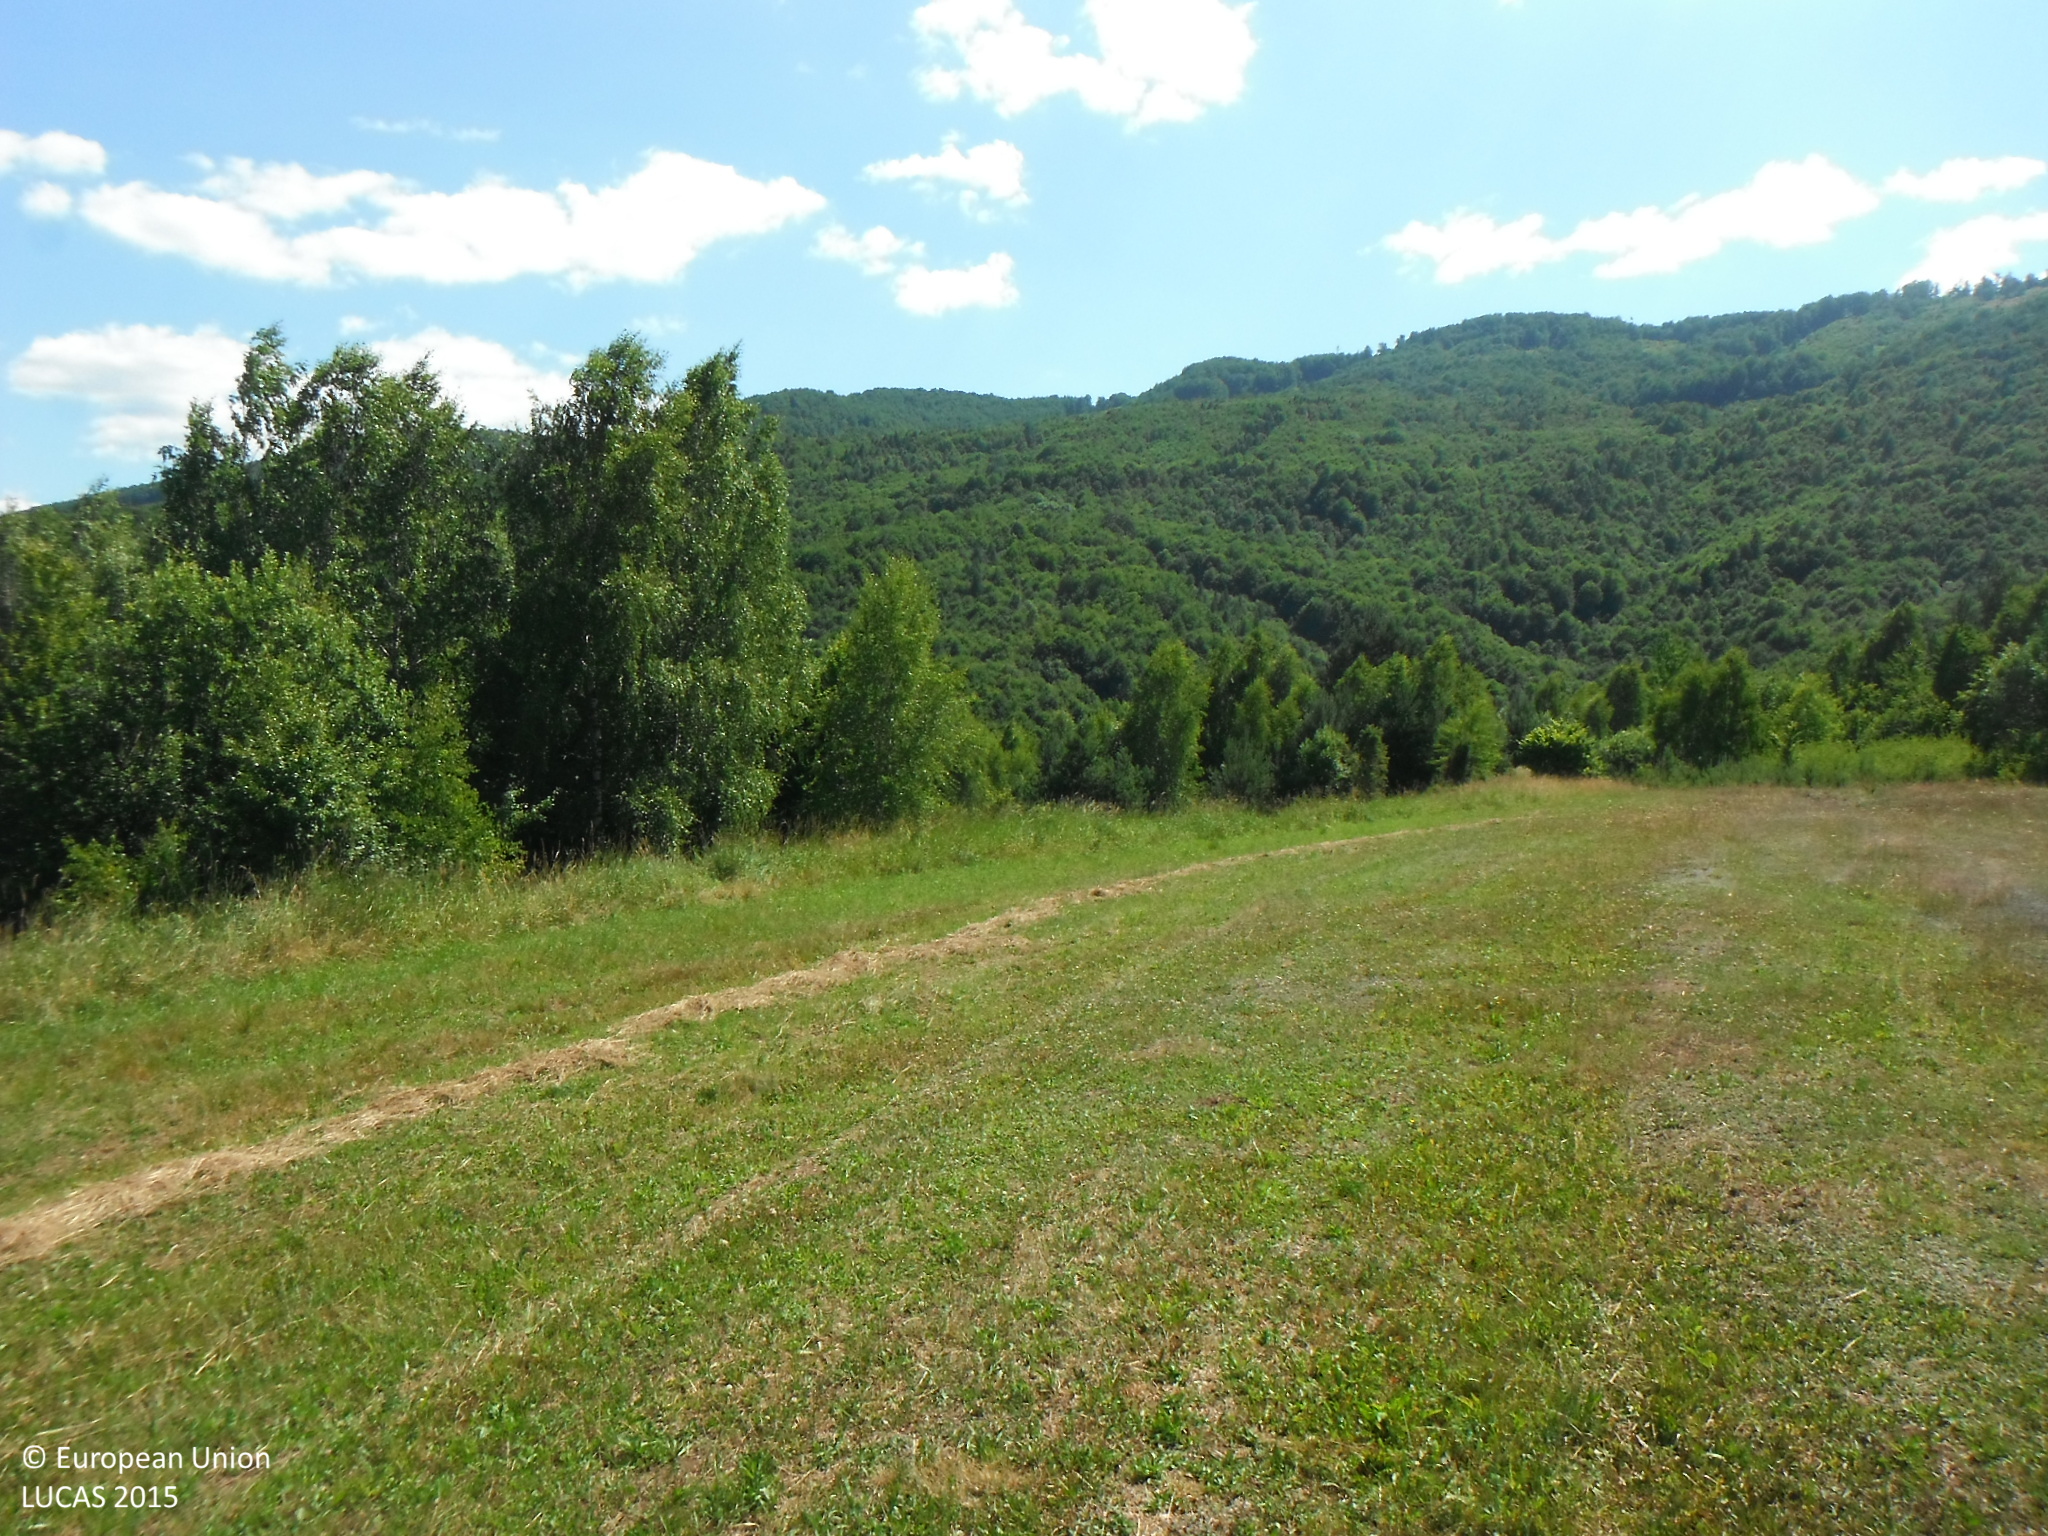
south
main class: Grassland
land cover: Grassland without tree/shrub cover
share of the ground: > 75 %
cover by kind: herbaceous plants 100 %
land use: Agriculture (excluding fallow land and kitchen gardens)
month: July
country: SK
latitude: 49.0680
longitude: 22.3942
